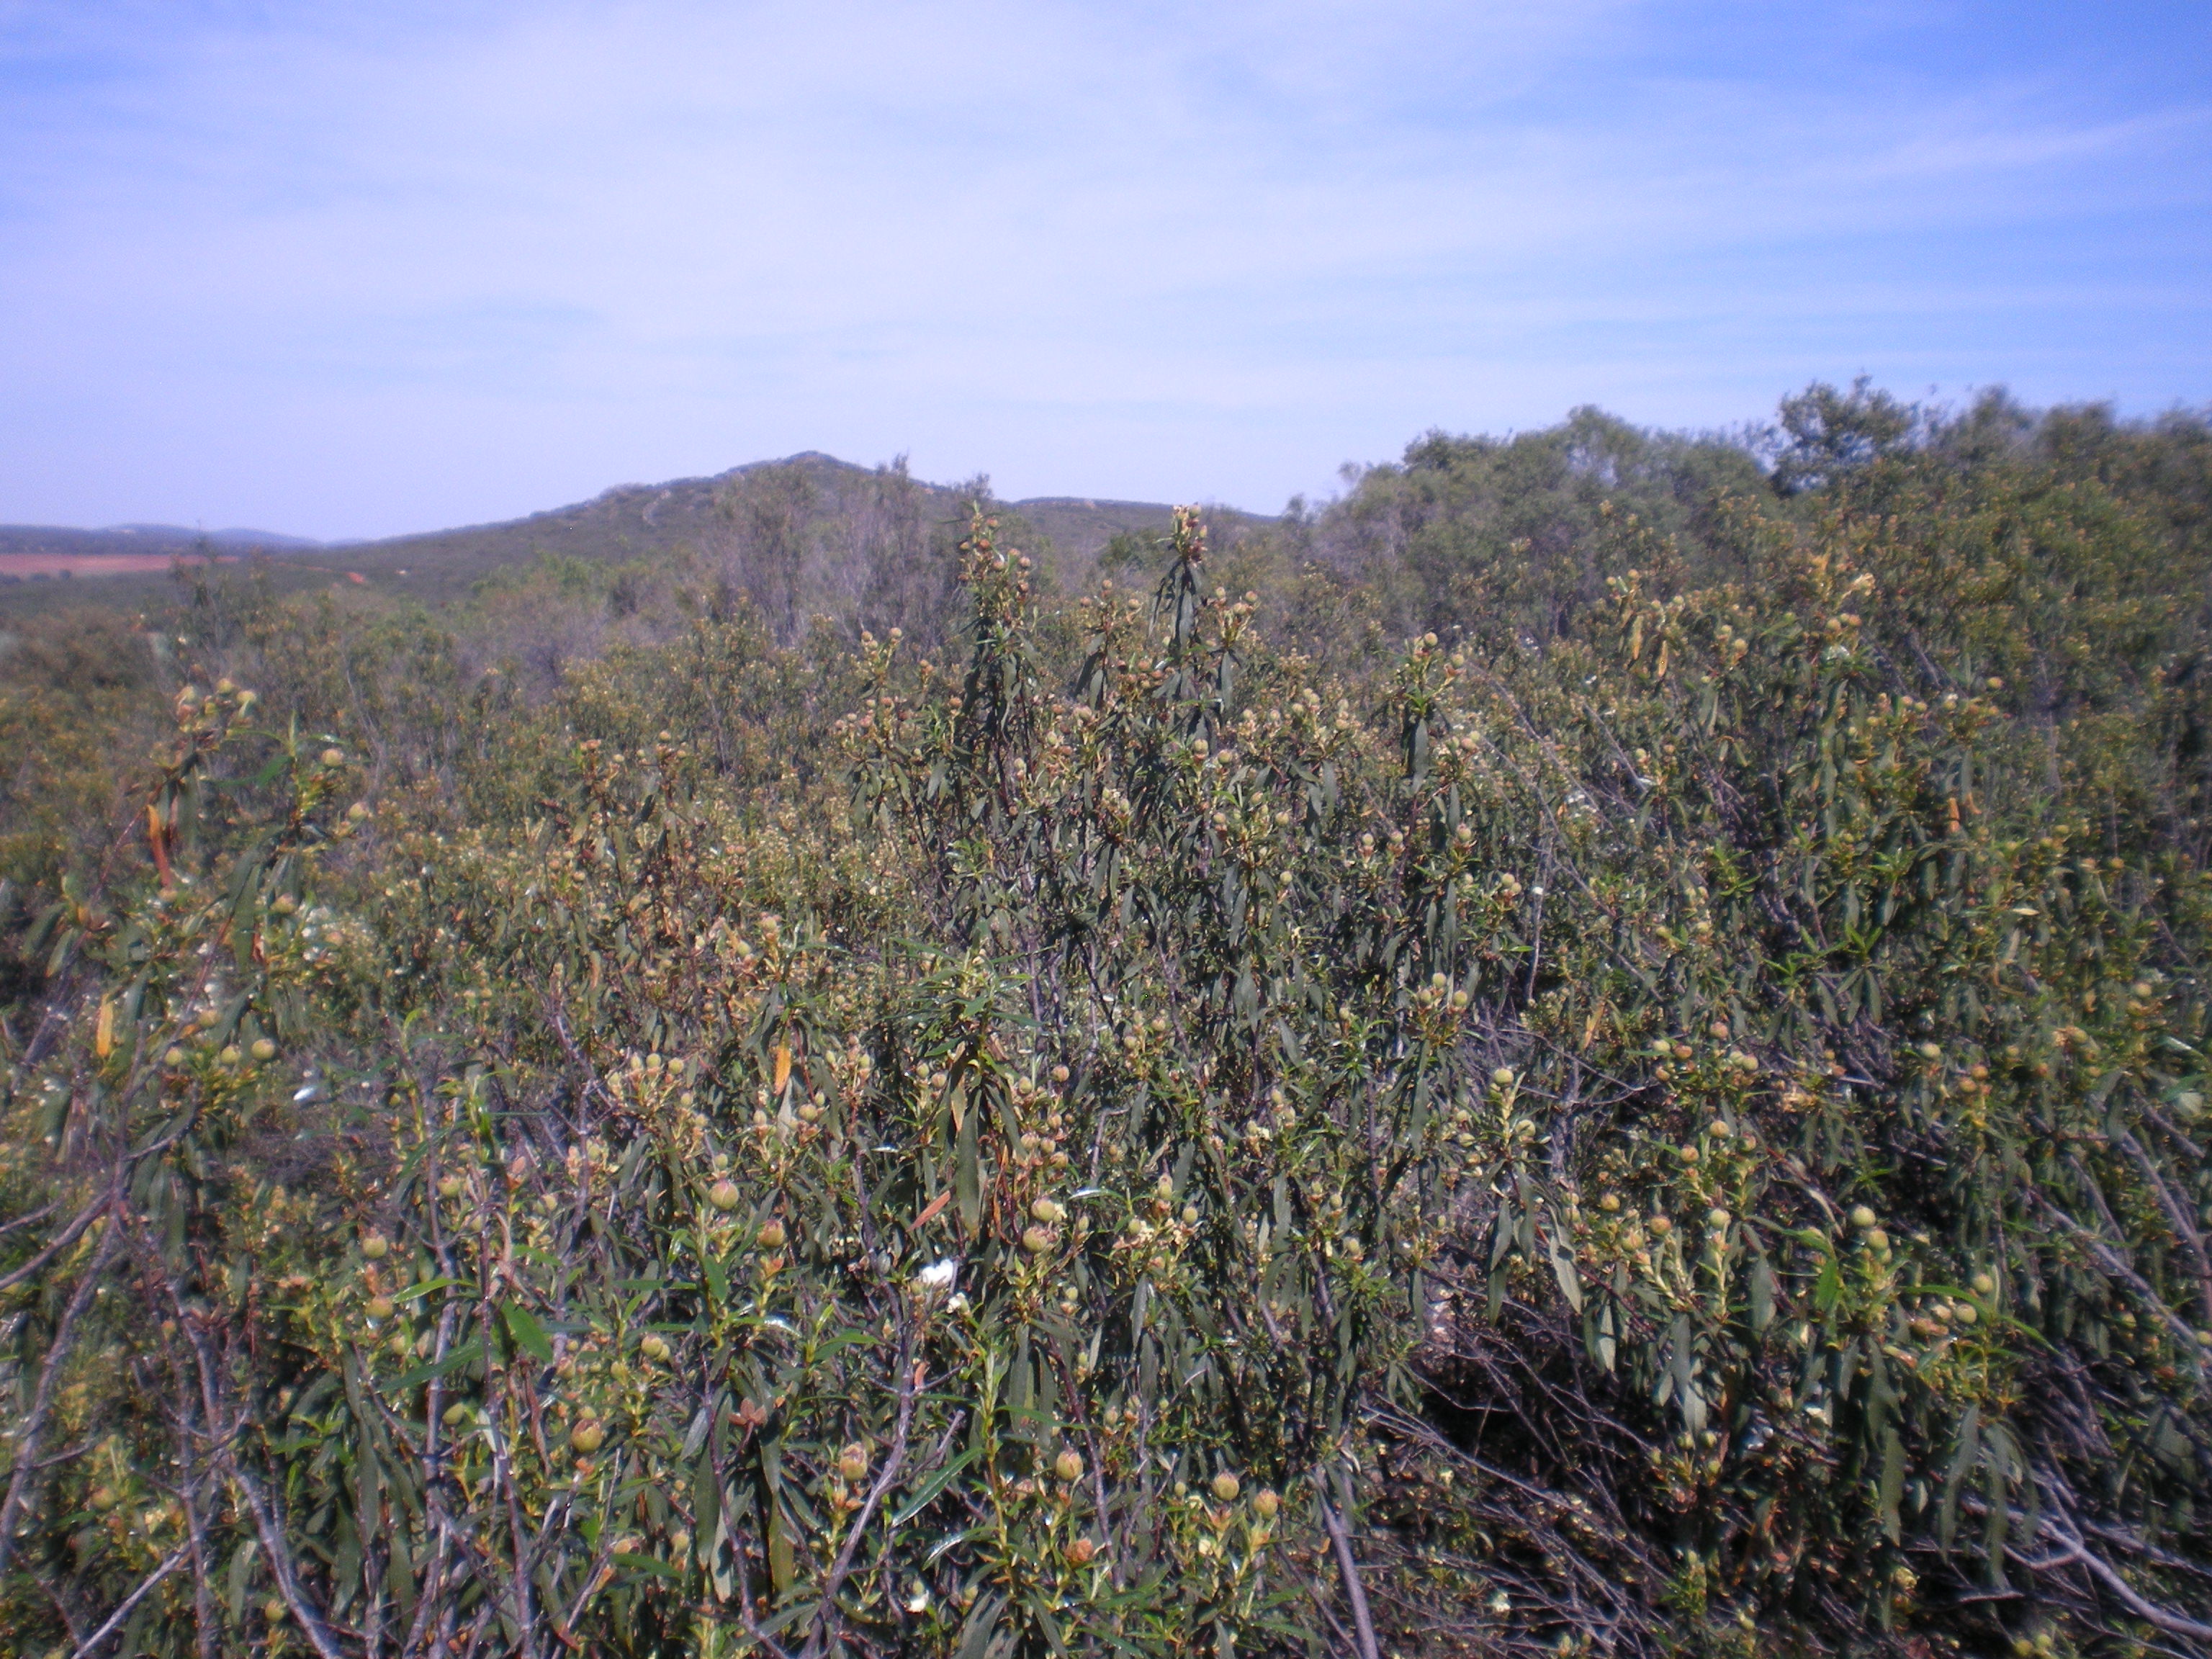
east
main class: Shrubland
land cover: Shrubland with sparse tree cover
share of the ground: > 75 %
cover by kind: shrubs 80 %, herbaceous plants 10 %, broadleaved forest trees 5 %, unconsolidated bare surface 5 %
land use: Other primary production
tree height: < 5 m
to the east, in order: Shrubland with sparse tree cover; Broadleaved woodland; Other structural elements; Broadleaved woodland
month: May
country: ES
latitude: 38.5283
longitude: -3.4638
